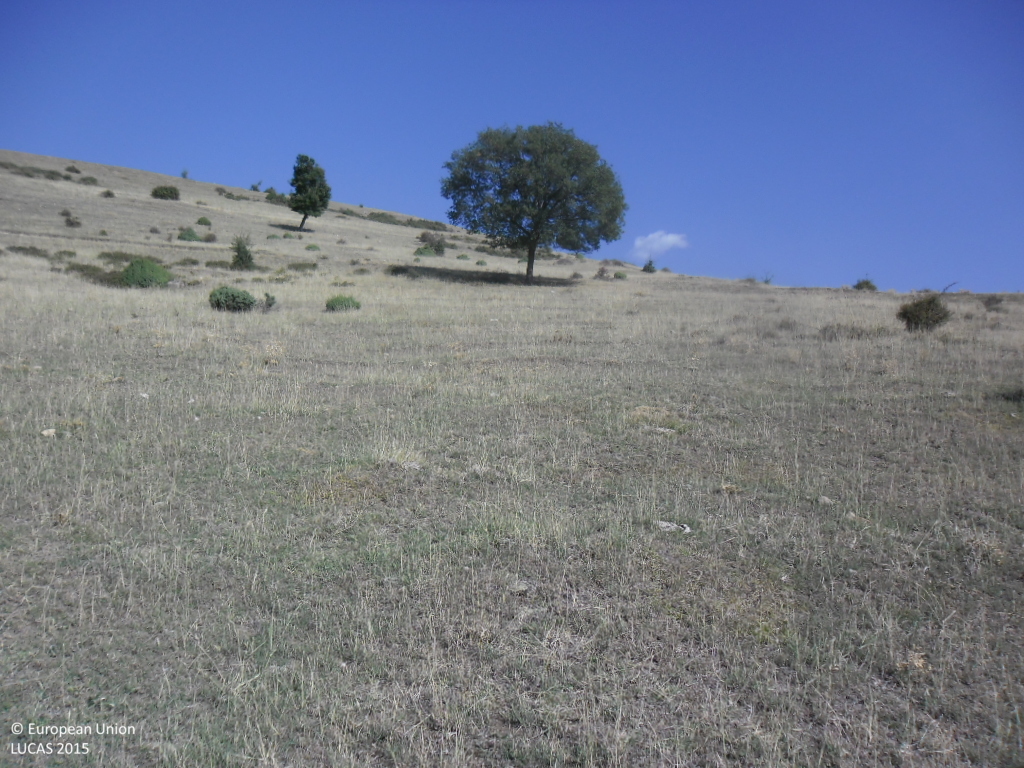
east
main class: Grassland
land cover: Grassland without tree/shrub cover
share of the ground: > 75 %
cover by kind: herbaceous plants 100 %
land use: Agriculture (excluding fallow land and kitchen gardens)
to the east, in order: Grassland without tree/shrub cover; Single bushes/trees; Grassland with sparse tree/shrub cover; Tracks; Grassland without tree/shrub cover; Tracks; Grassland without tree/shrub cover; Tracks; Grassland without tree/shrub cover
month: September
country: BG
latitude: 41.5927
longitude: 23.2784
